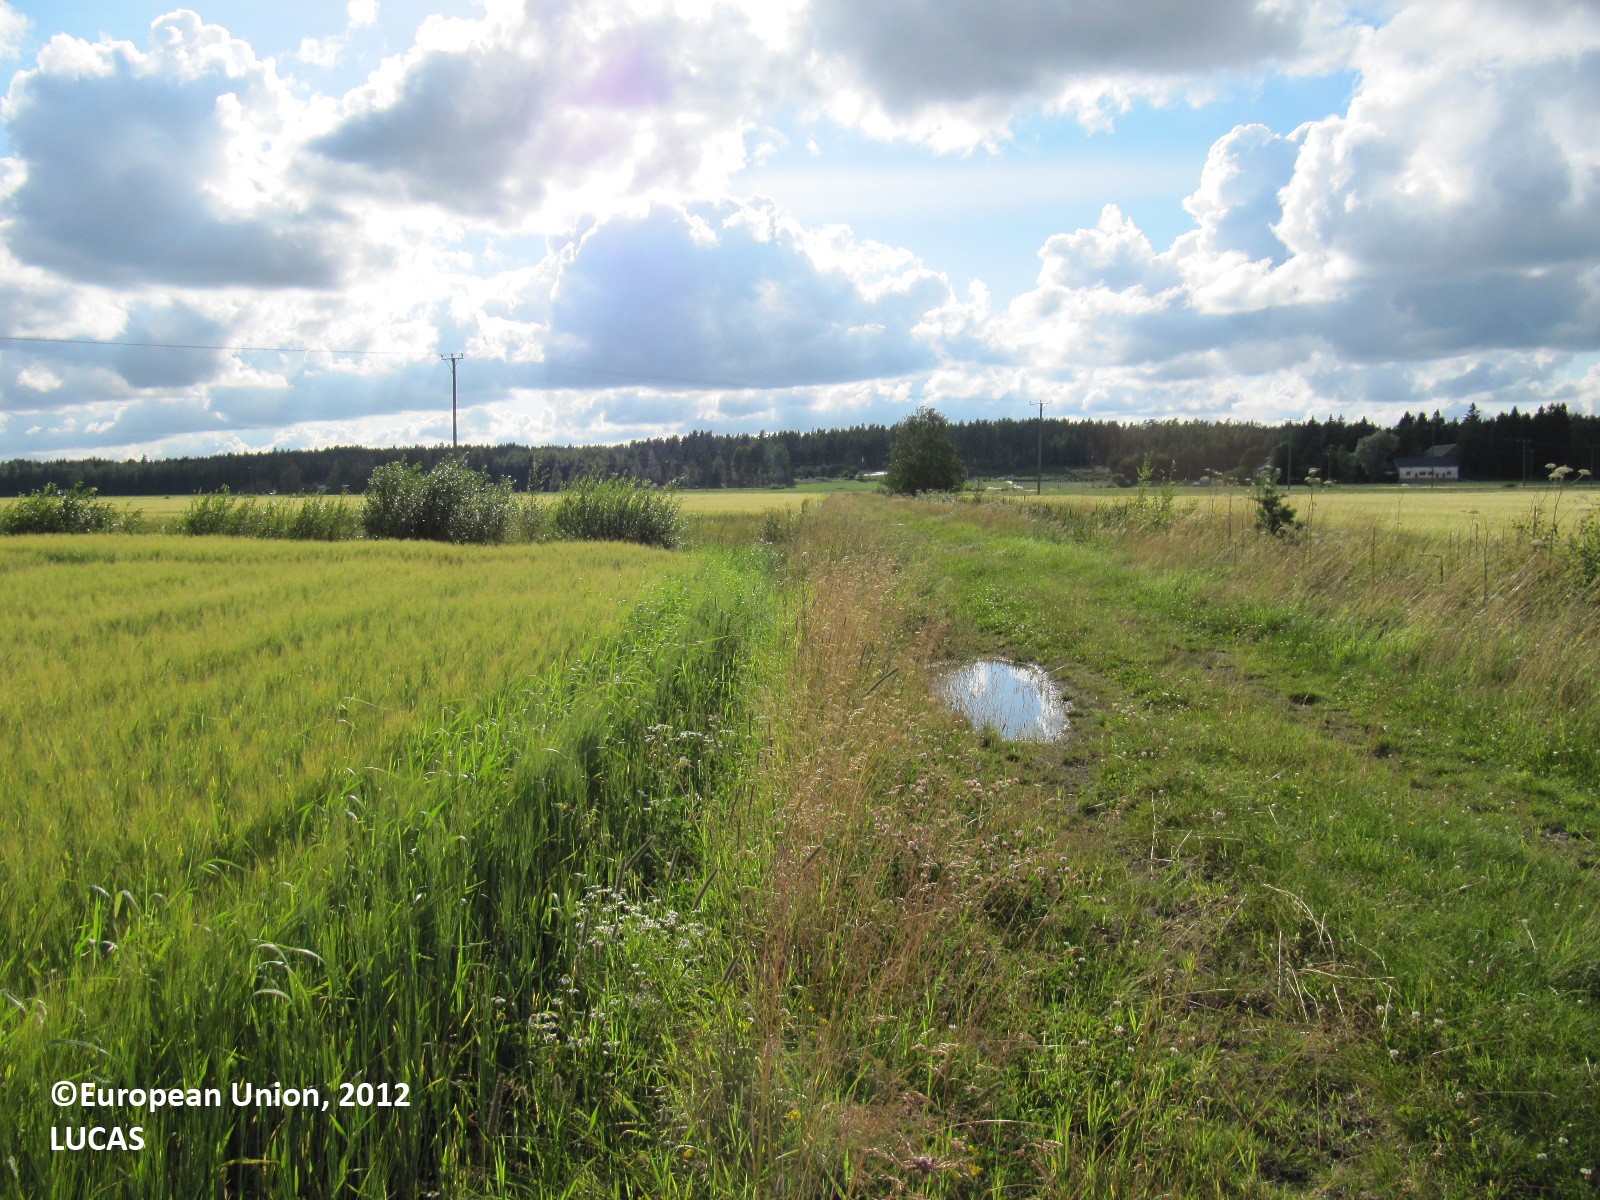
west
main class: Cropland
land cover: Barley
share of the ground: > 75 %
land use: Agriculture (excluding fallow land and kitchen gardens)
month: July
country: FI
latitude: 60.4431
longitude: 23.1108
